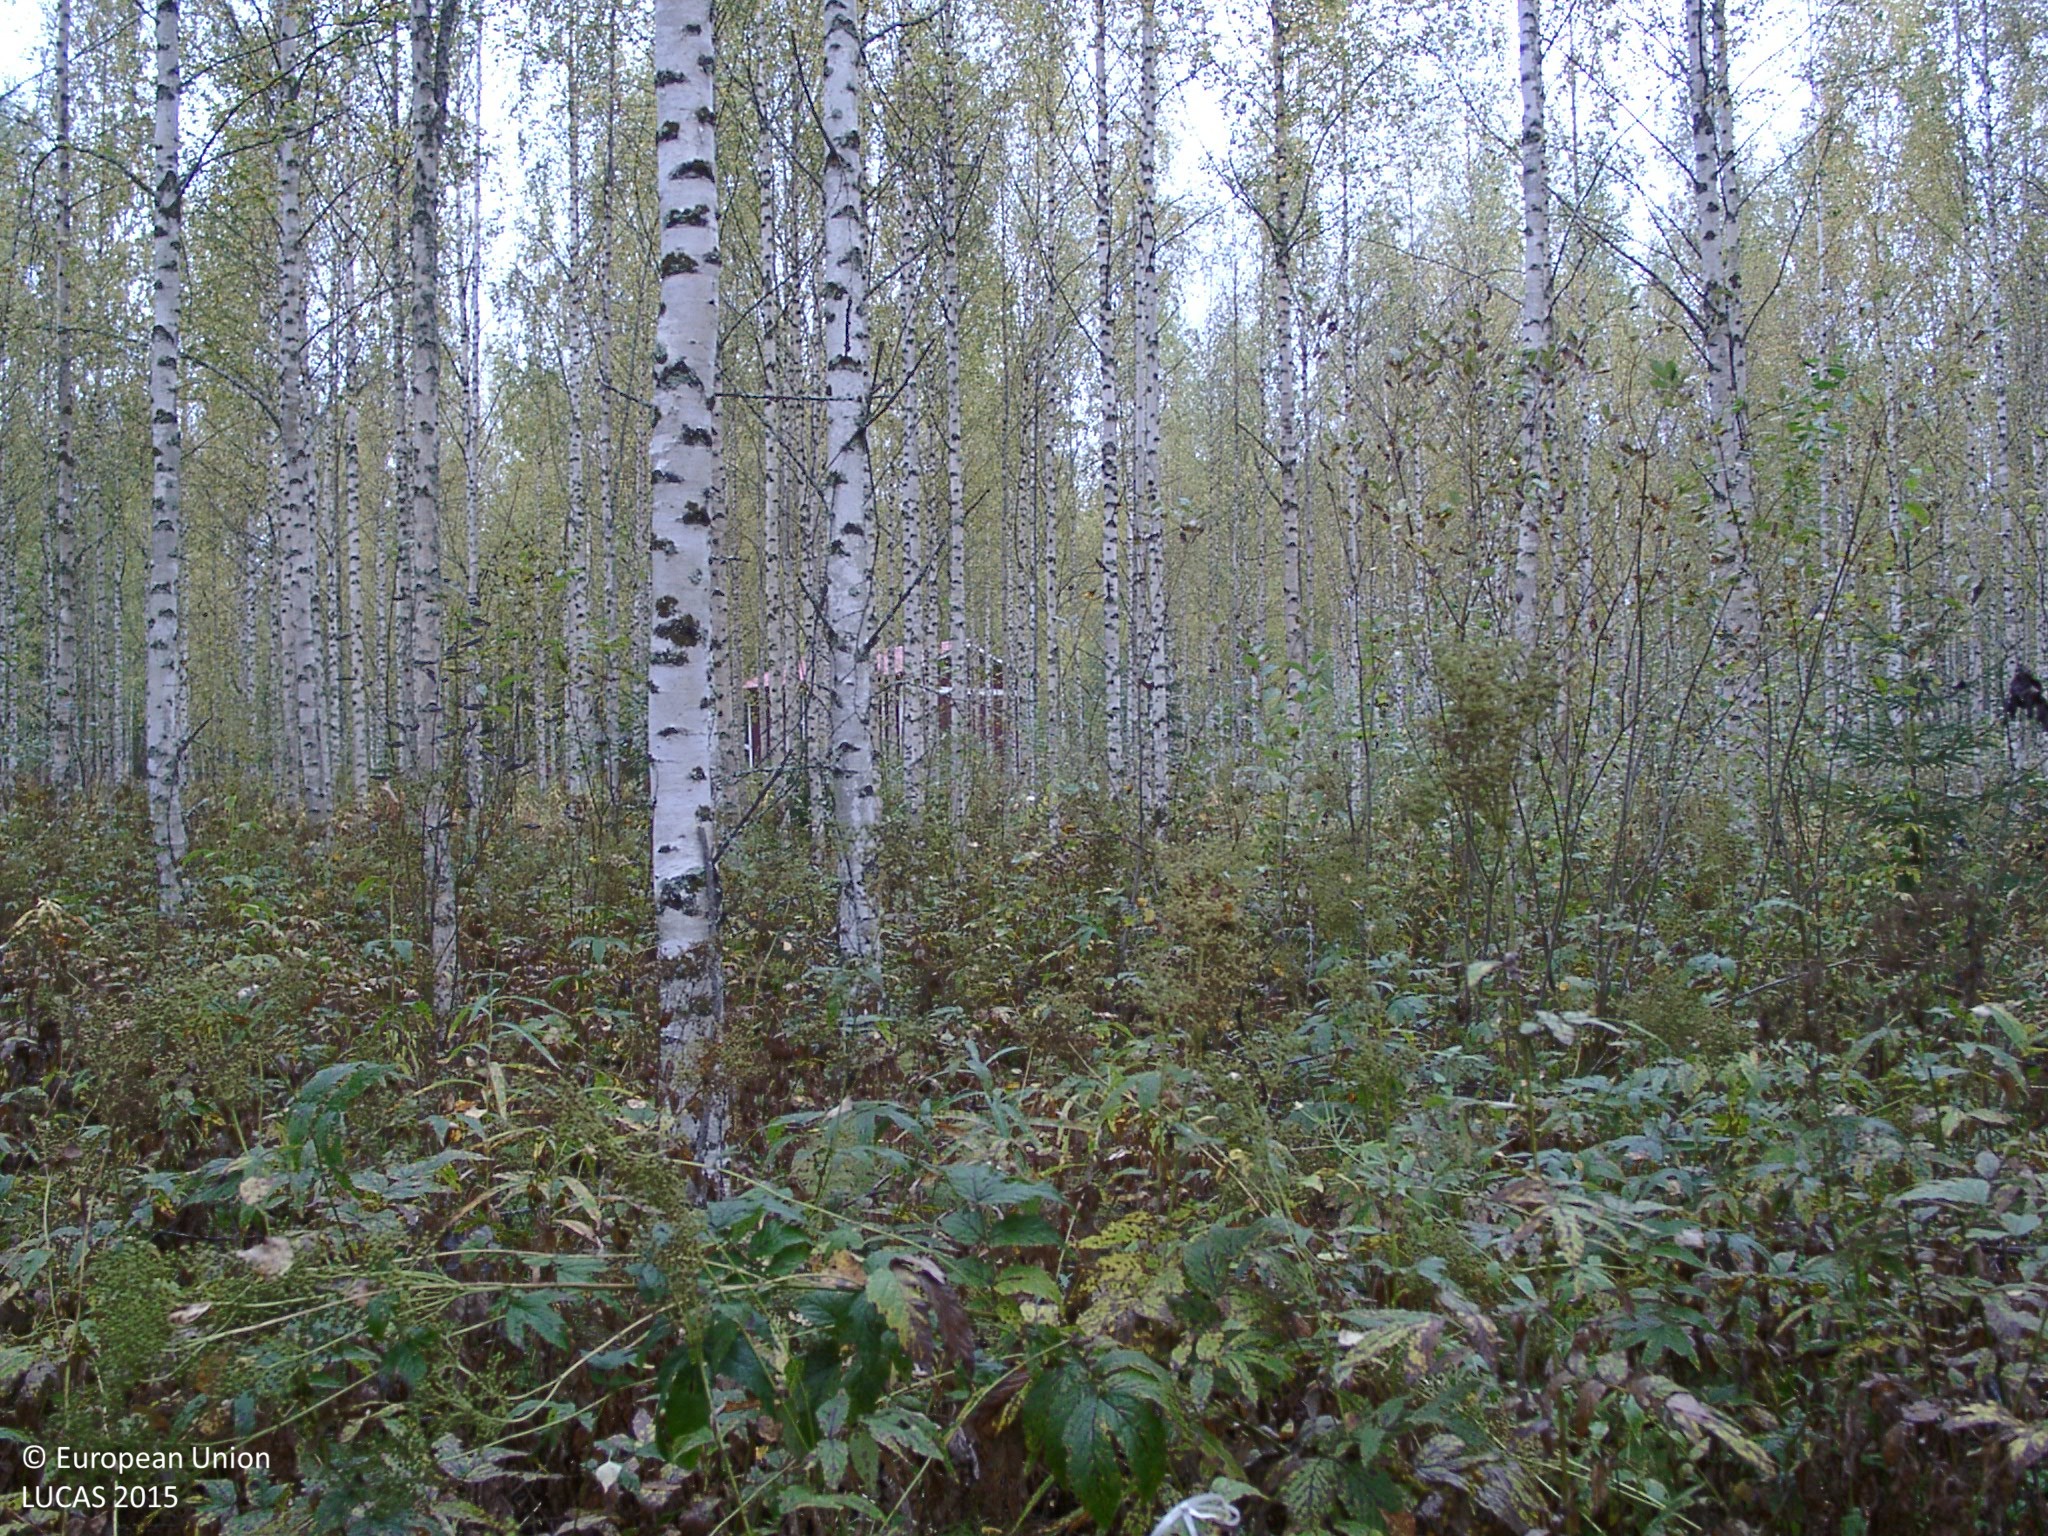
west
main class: Woodland
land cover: Broadleaved woodland
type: non-riverine alder, birch or aspen forest
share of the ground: 50 - 75 %
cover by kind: broadleaved forest trees 65 %, herbaceous plants 30 %, shrubs 5 %
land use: Forestry
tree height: > 5 m
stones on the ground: < 10 %
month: September
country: FI
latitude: 62.7577
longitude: 25.3600
